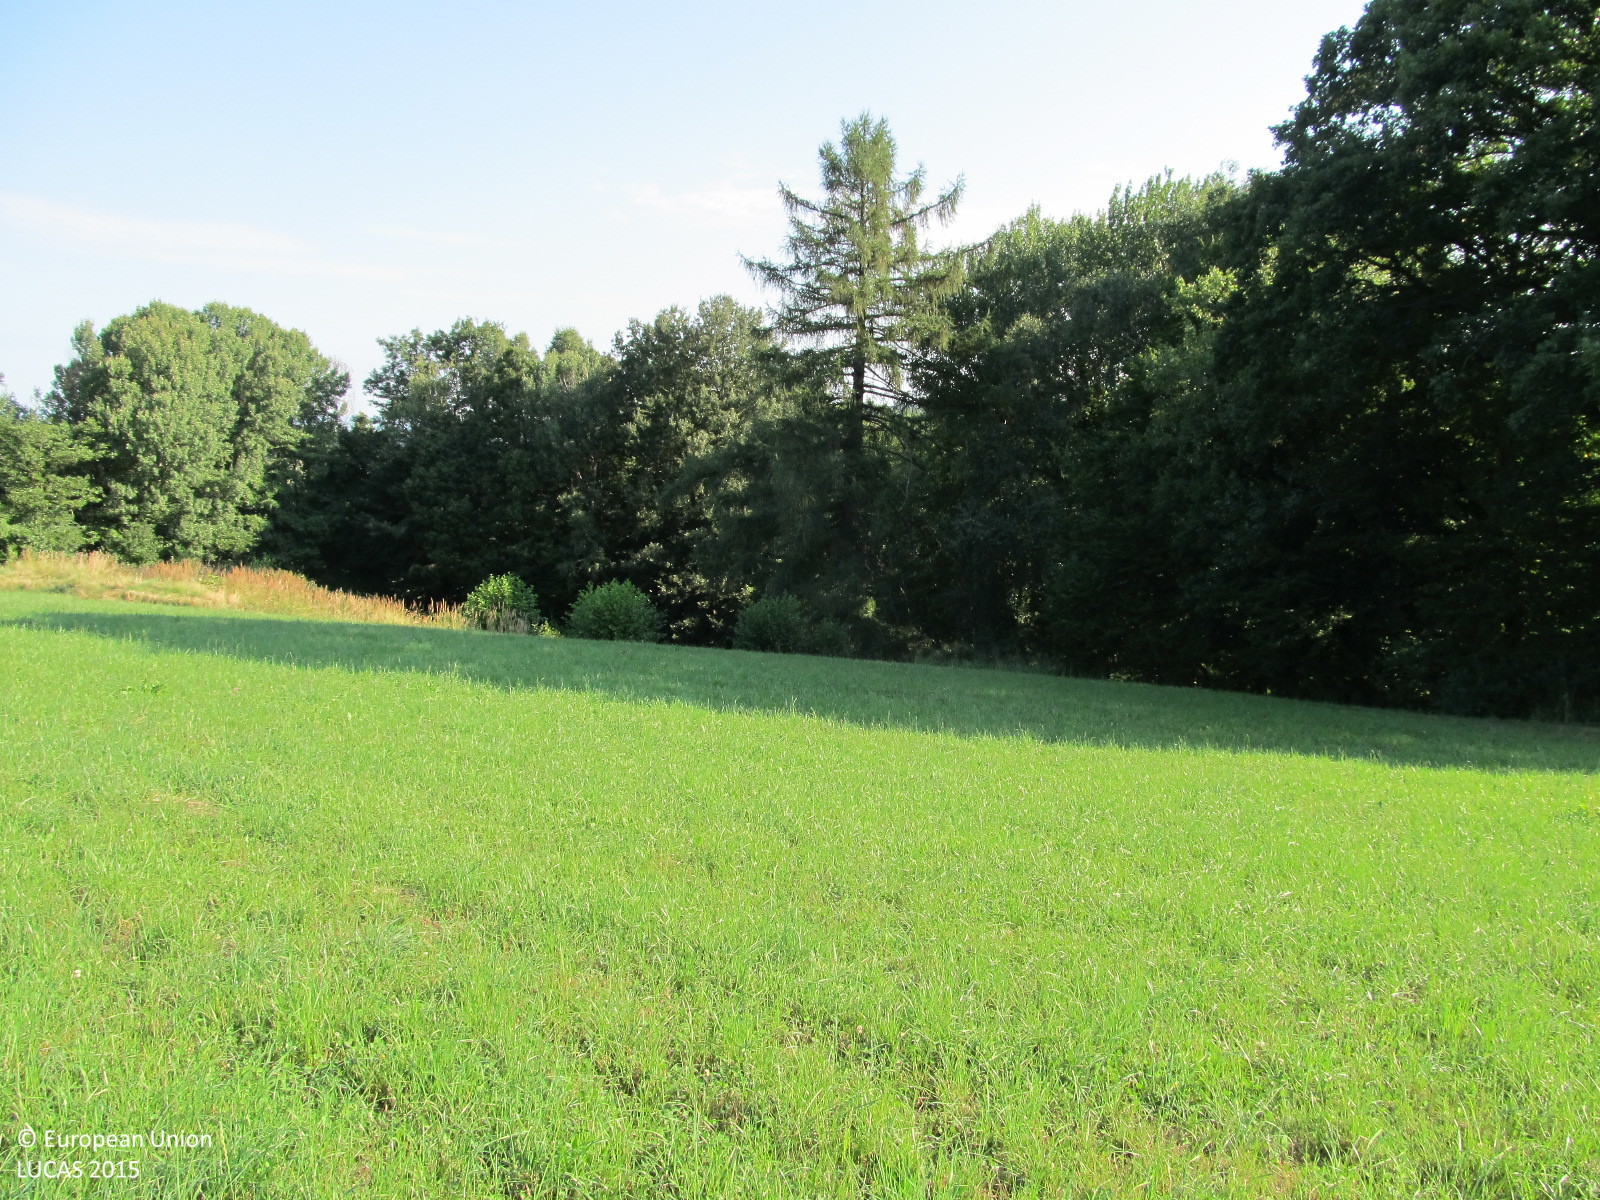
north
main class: Grassland
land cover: Grassland without tree/shrub cover
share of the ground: > 75 %
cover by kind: herbaceous plants 100 %
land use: Agriculture (excluding fallow land and kitchen gardens)
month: August
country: AT
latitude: 48.1447
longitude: 15.7687
